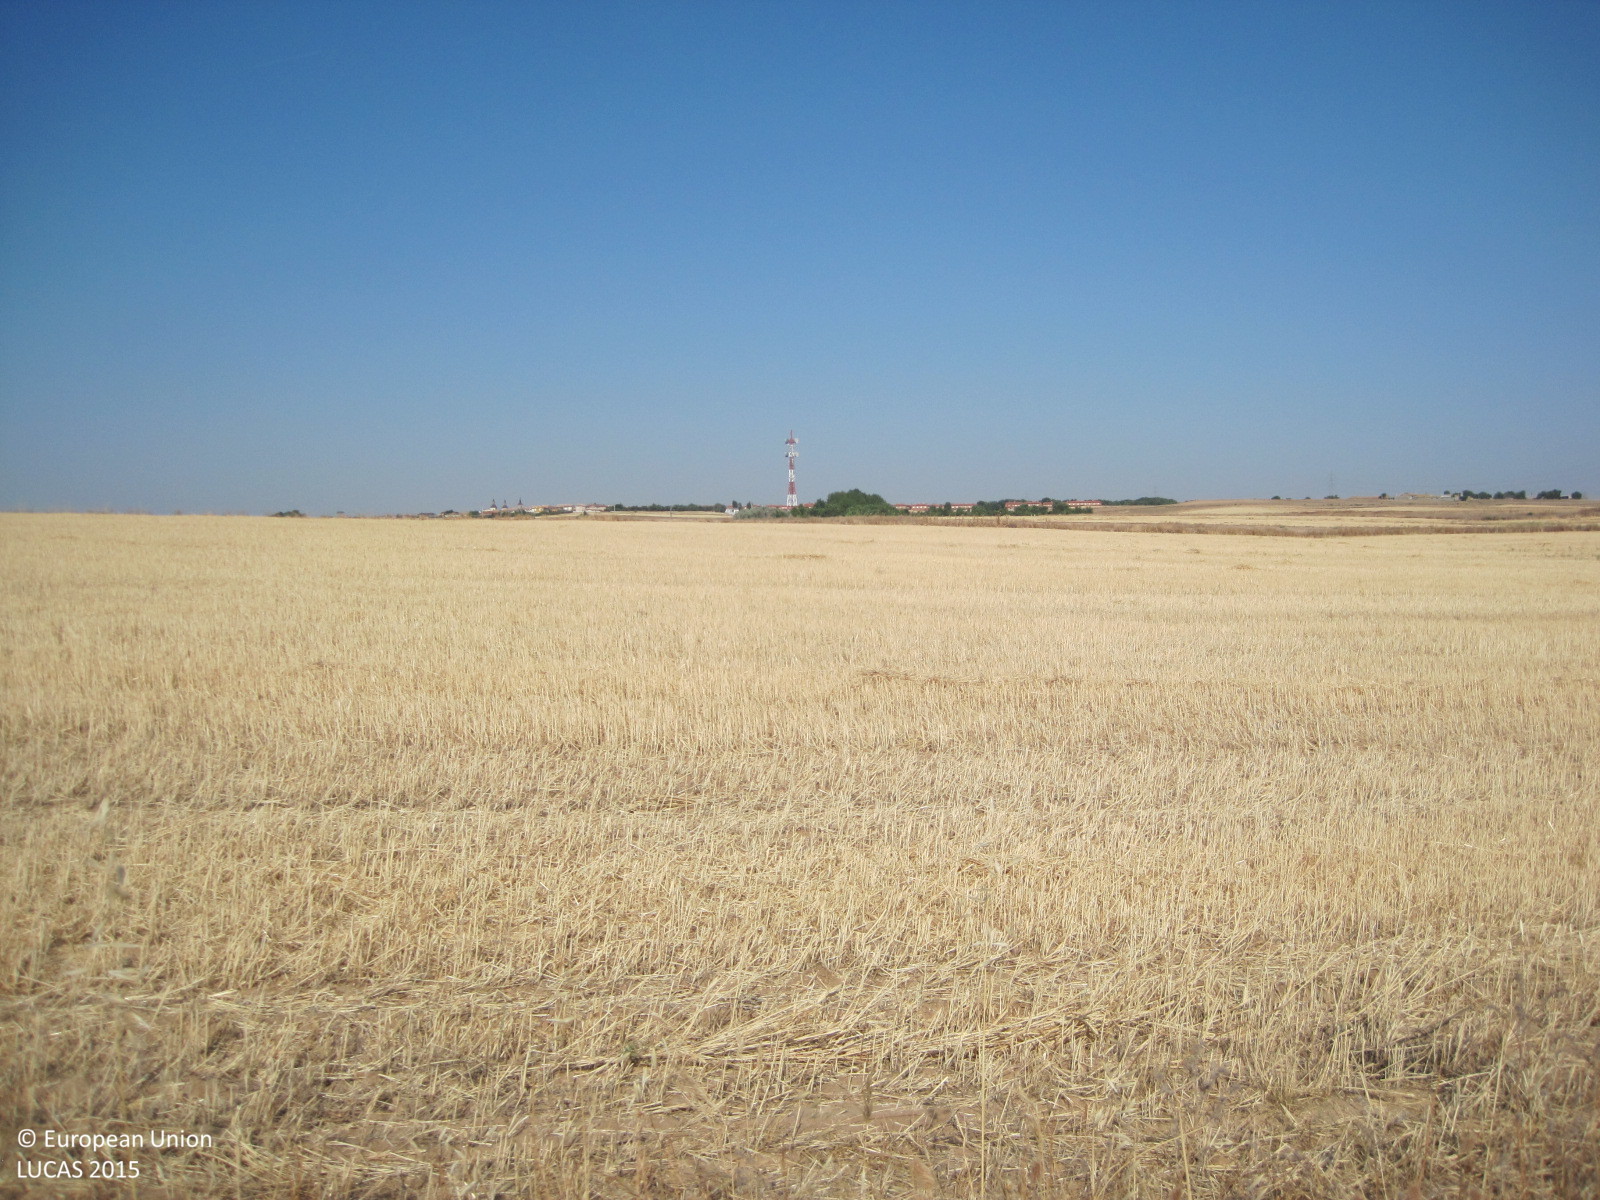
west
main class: Cropland
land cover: Common wheat
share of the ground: < 10 %
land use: Agriculture (excluding fallow land and kitchen gardens)
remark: Harvested field
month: July
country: ES
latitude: 40.1587
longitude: -3.8547
